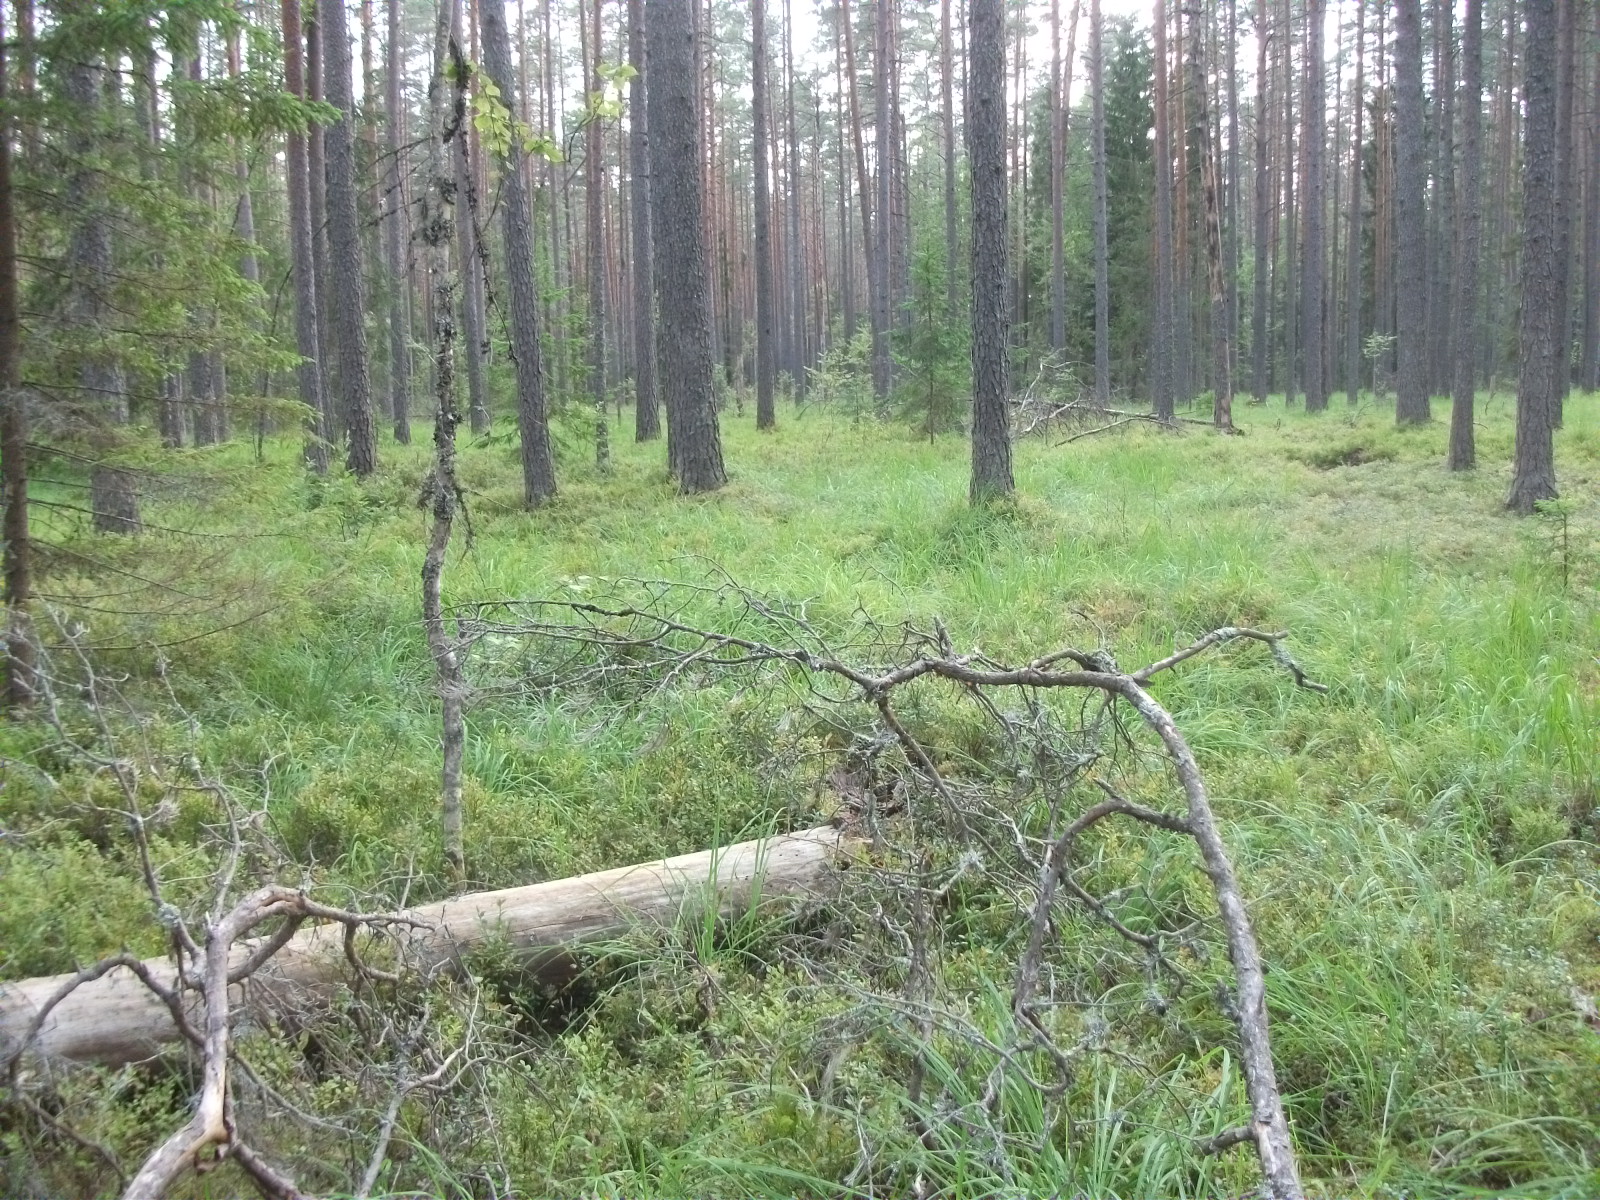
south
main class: Woodland
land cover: Other coniferous woodland
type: hemiboreal forest and nemoral coniferous forest and mixed broadleaved-coniferous forest
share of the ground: 50 - 75 %
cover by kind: coniferous forest trees 70 %, lichens and mosses 20 %, herbaceous plants 10 %
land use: Forestry
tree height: > 5 m
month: August
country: LV
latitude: 56.8533
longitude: 26.5287
